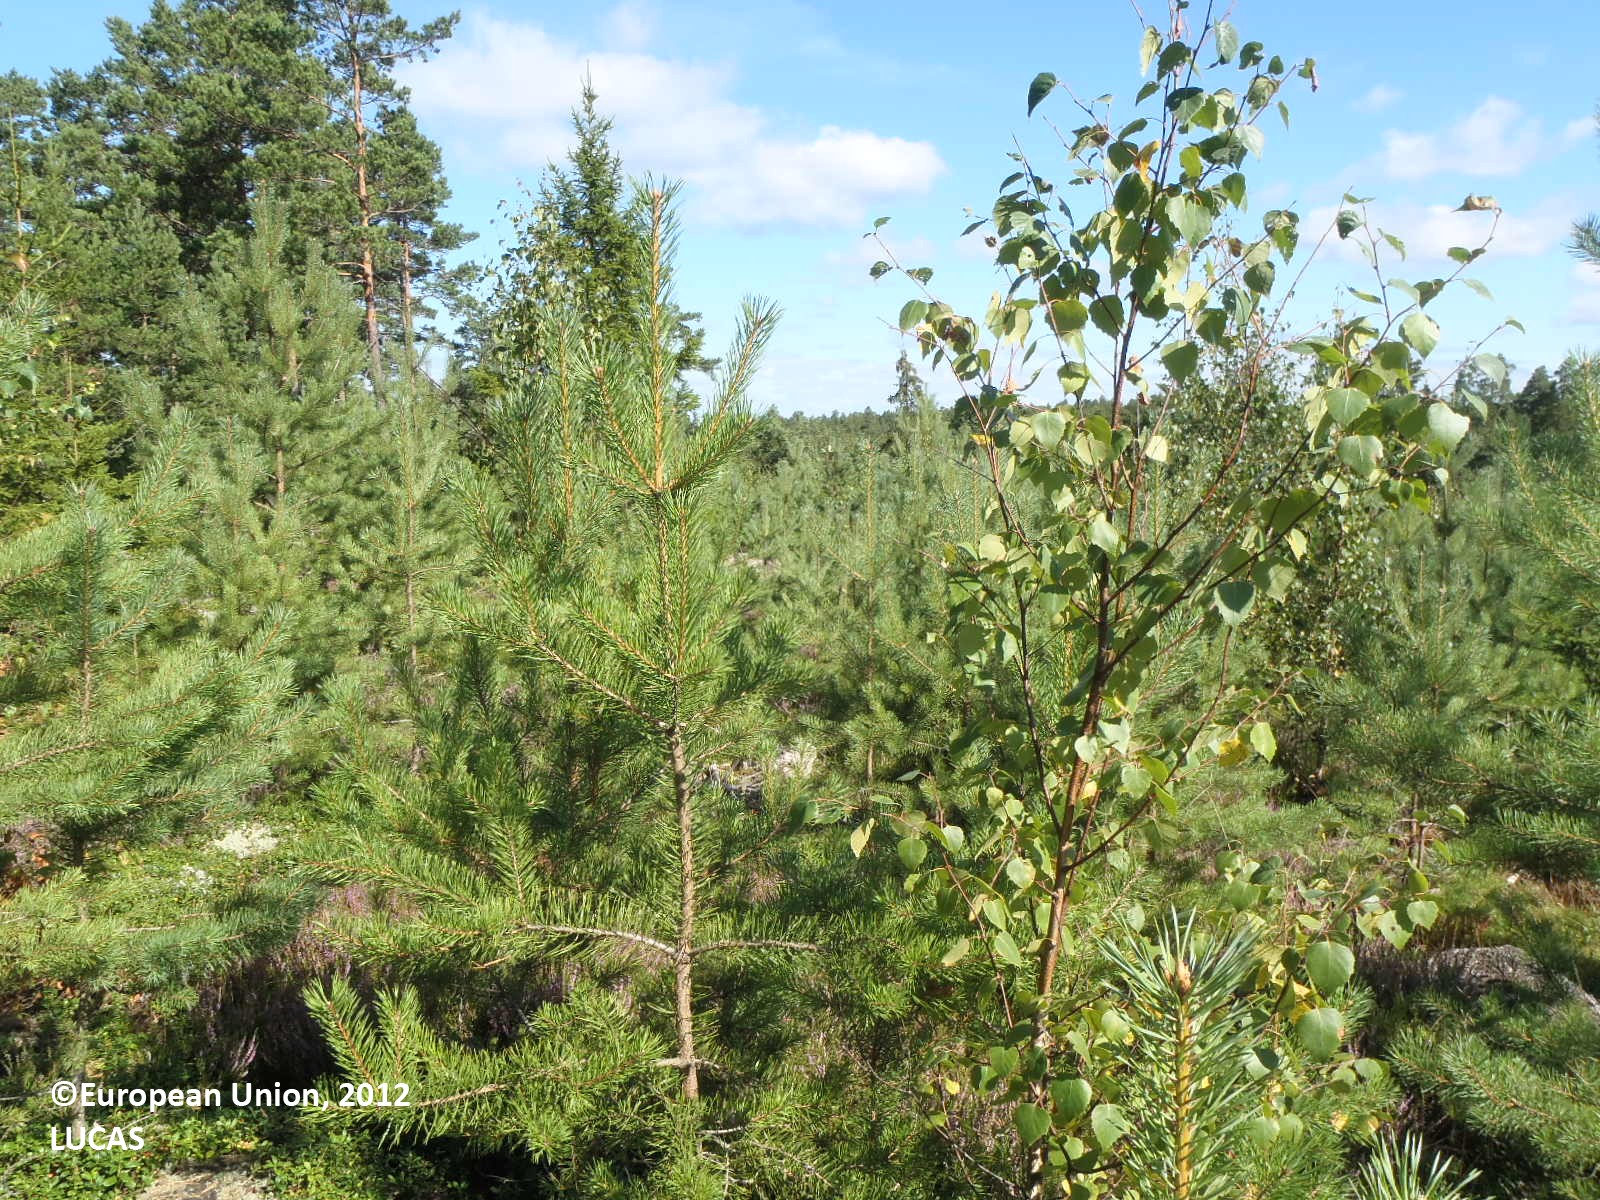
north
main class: Woodland
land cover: Pine dominated mixed woodland
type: boreal forest
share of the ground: 50 - 75 %
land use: Forestry
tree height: < 5 m
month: August
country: FI
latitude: 60.1932
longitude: 22.0228
